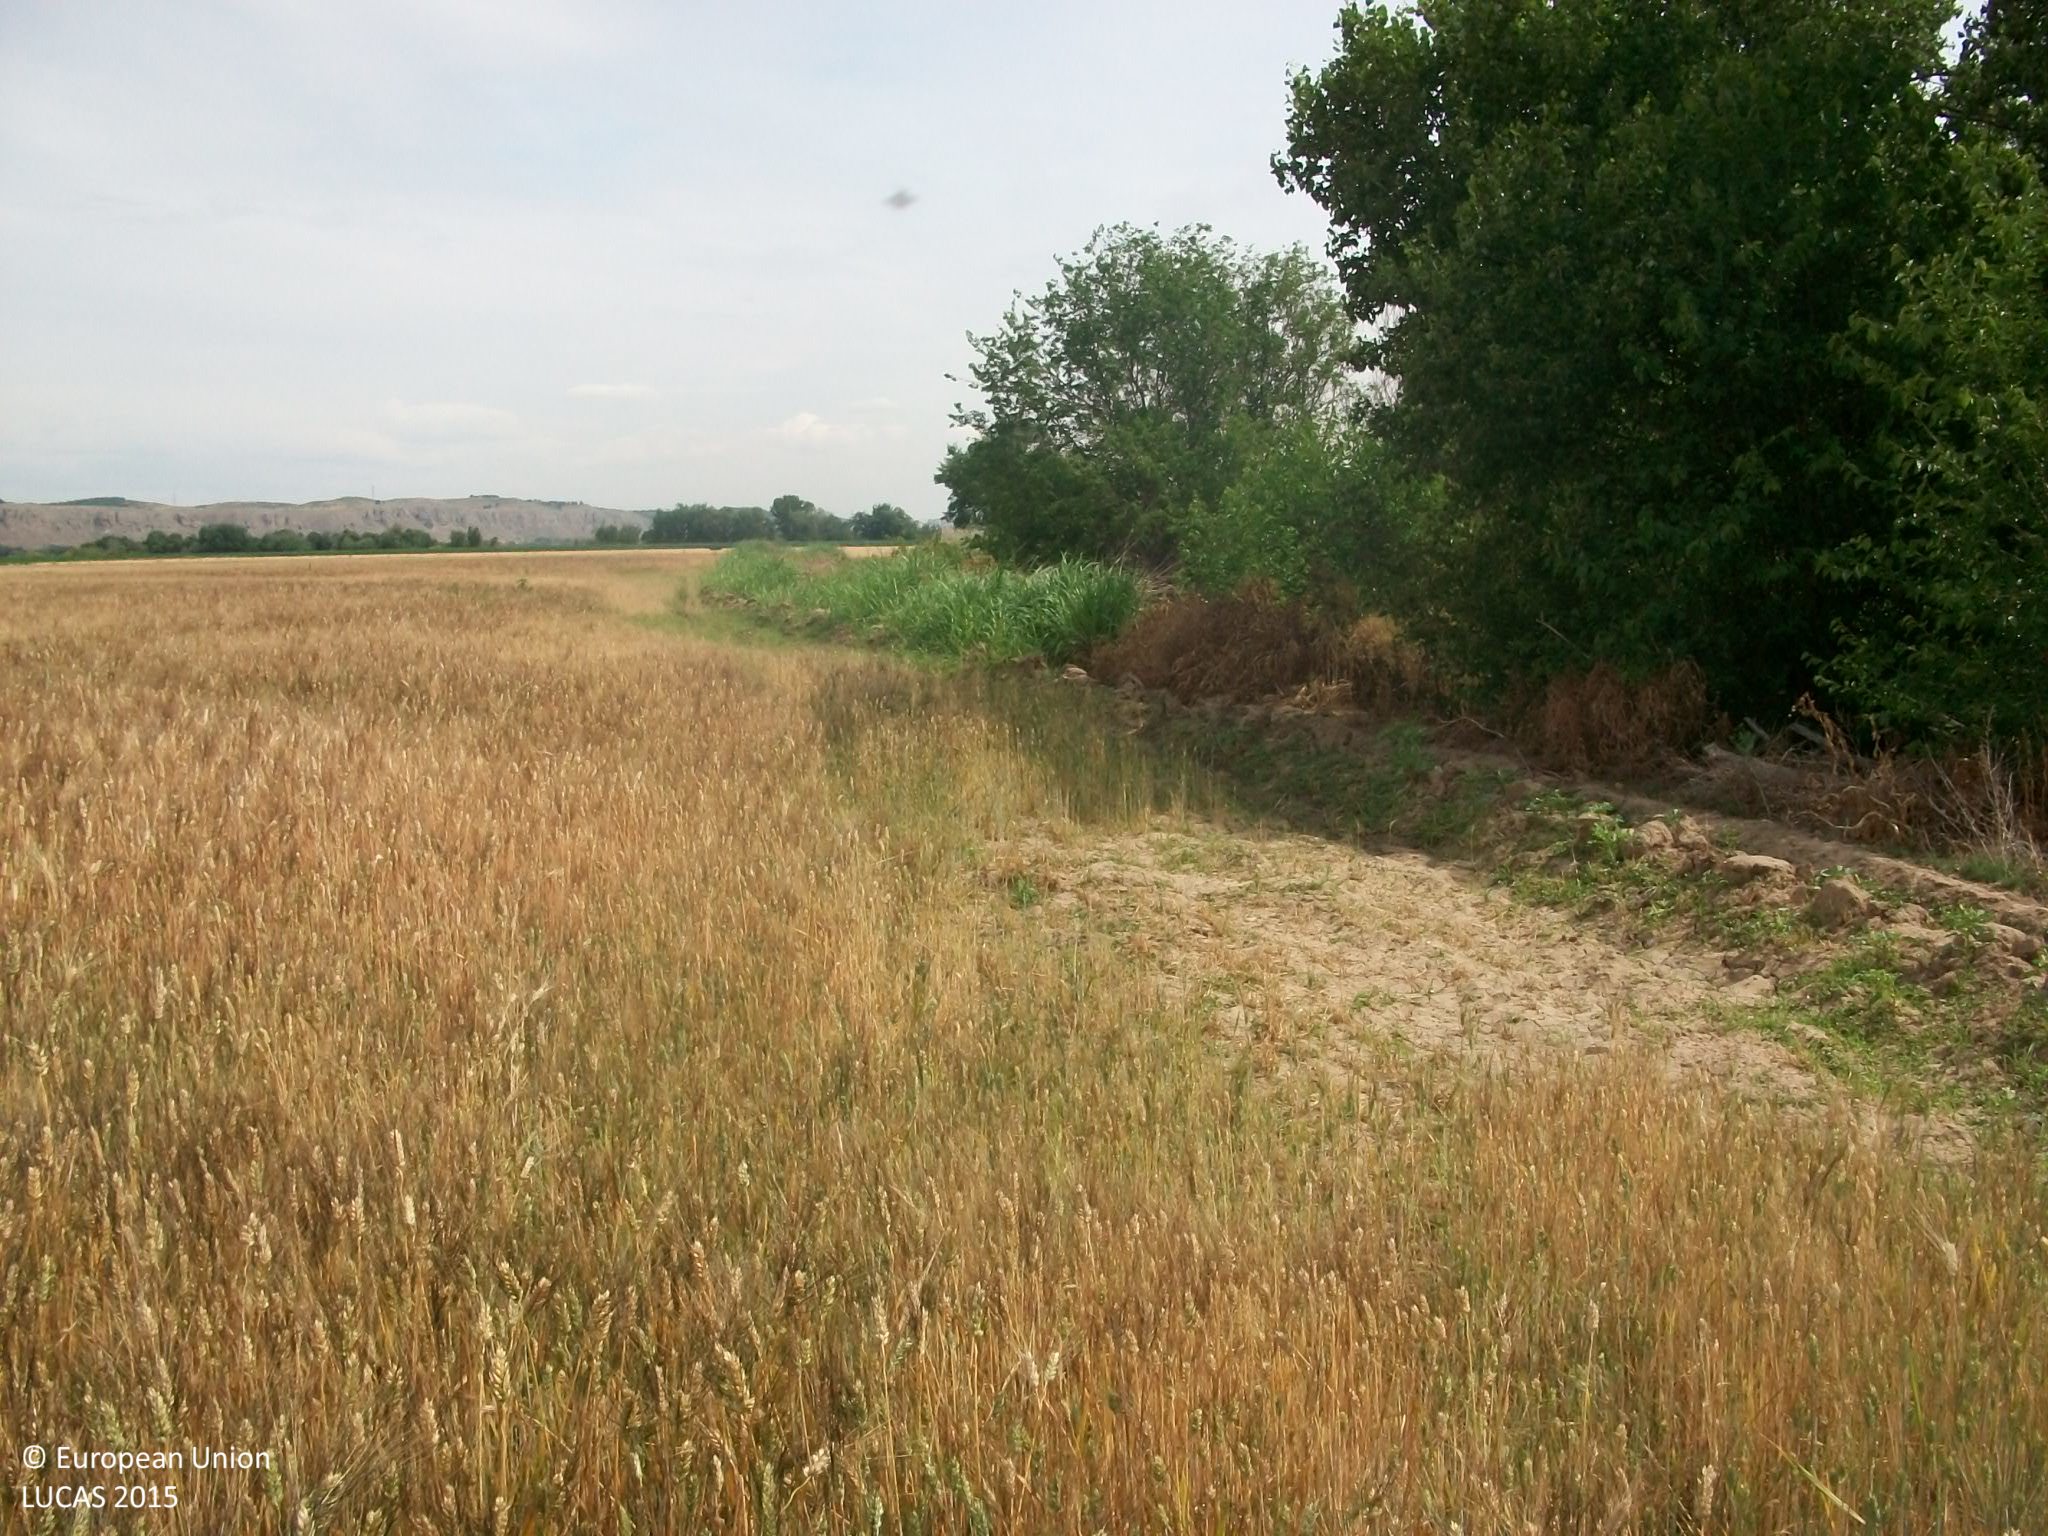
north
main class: Cropland
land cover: Common wheat
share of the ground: > 75 %
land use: Agriculture (excluding fallow land and kitchen gardens)
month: June
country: ES
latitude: 40.2576
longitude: -3.5428
